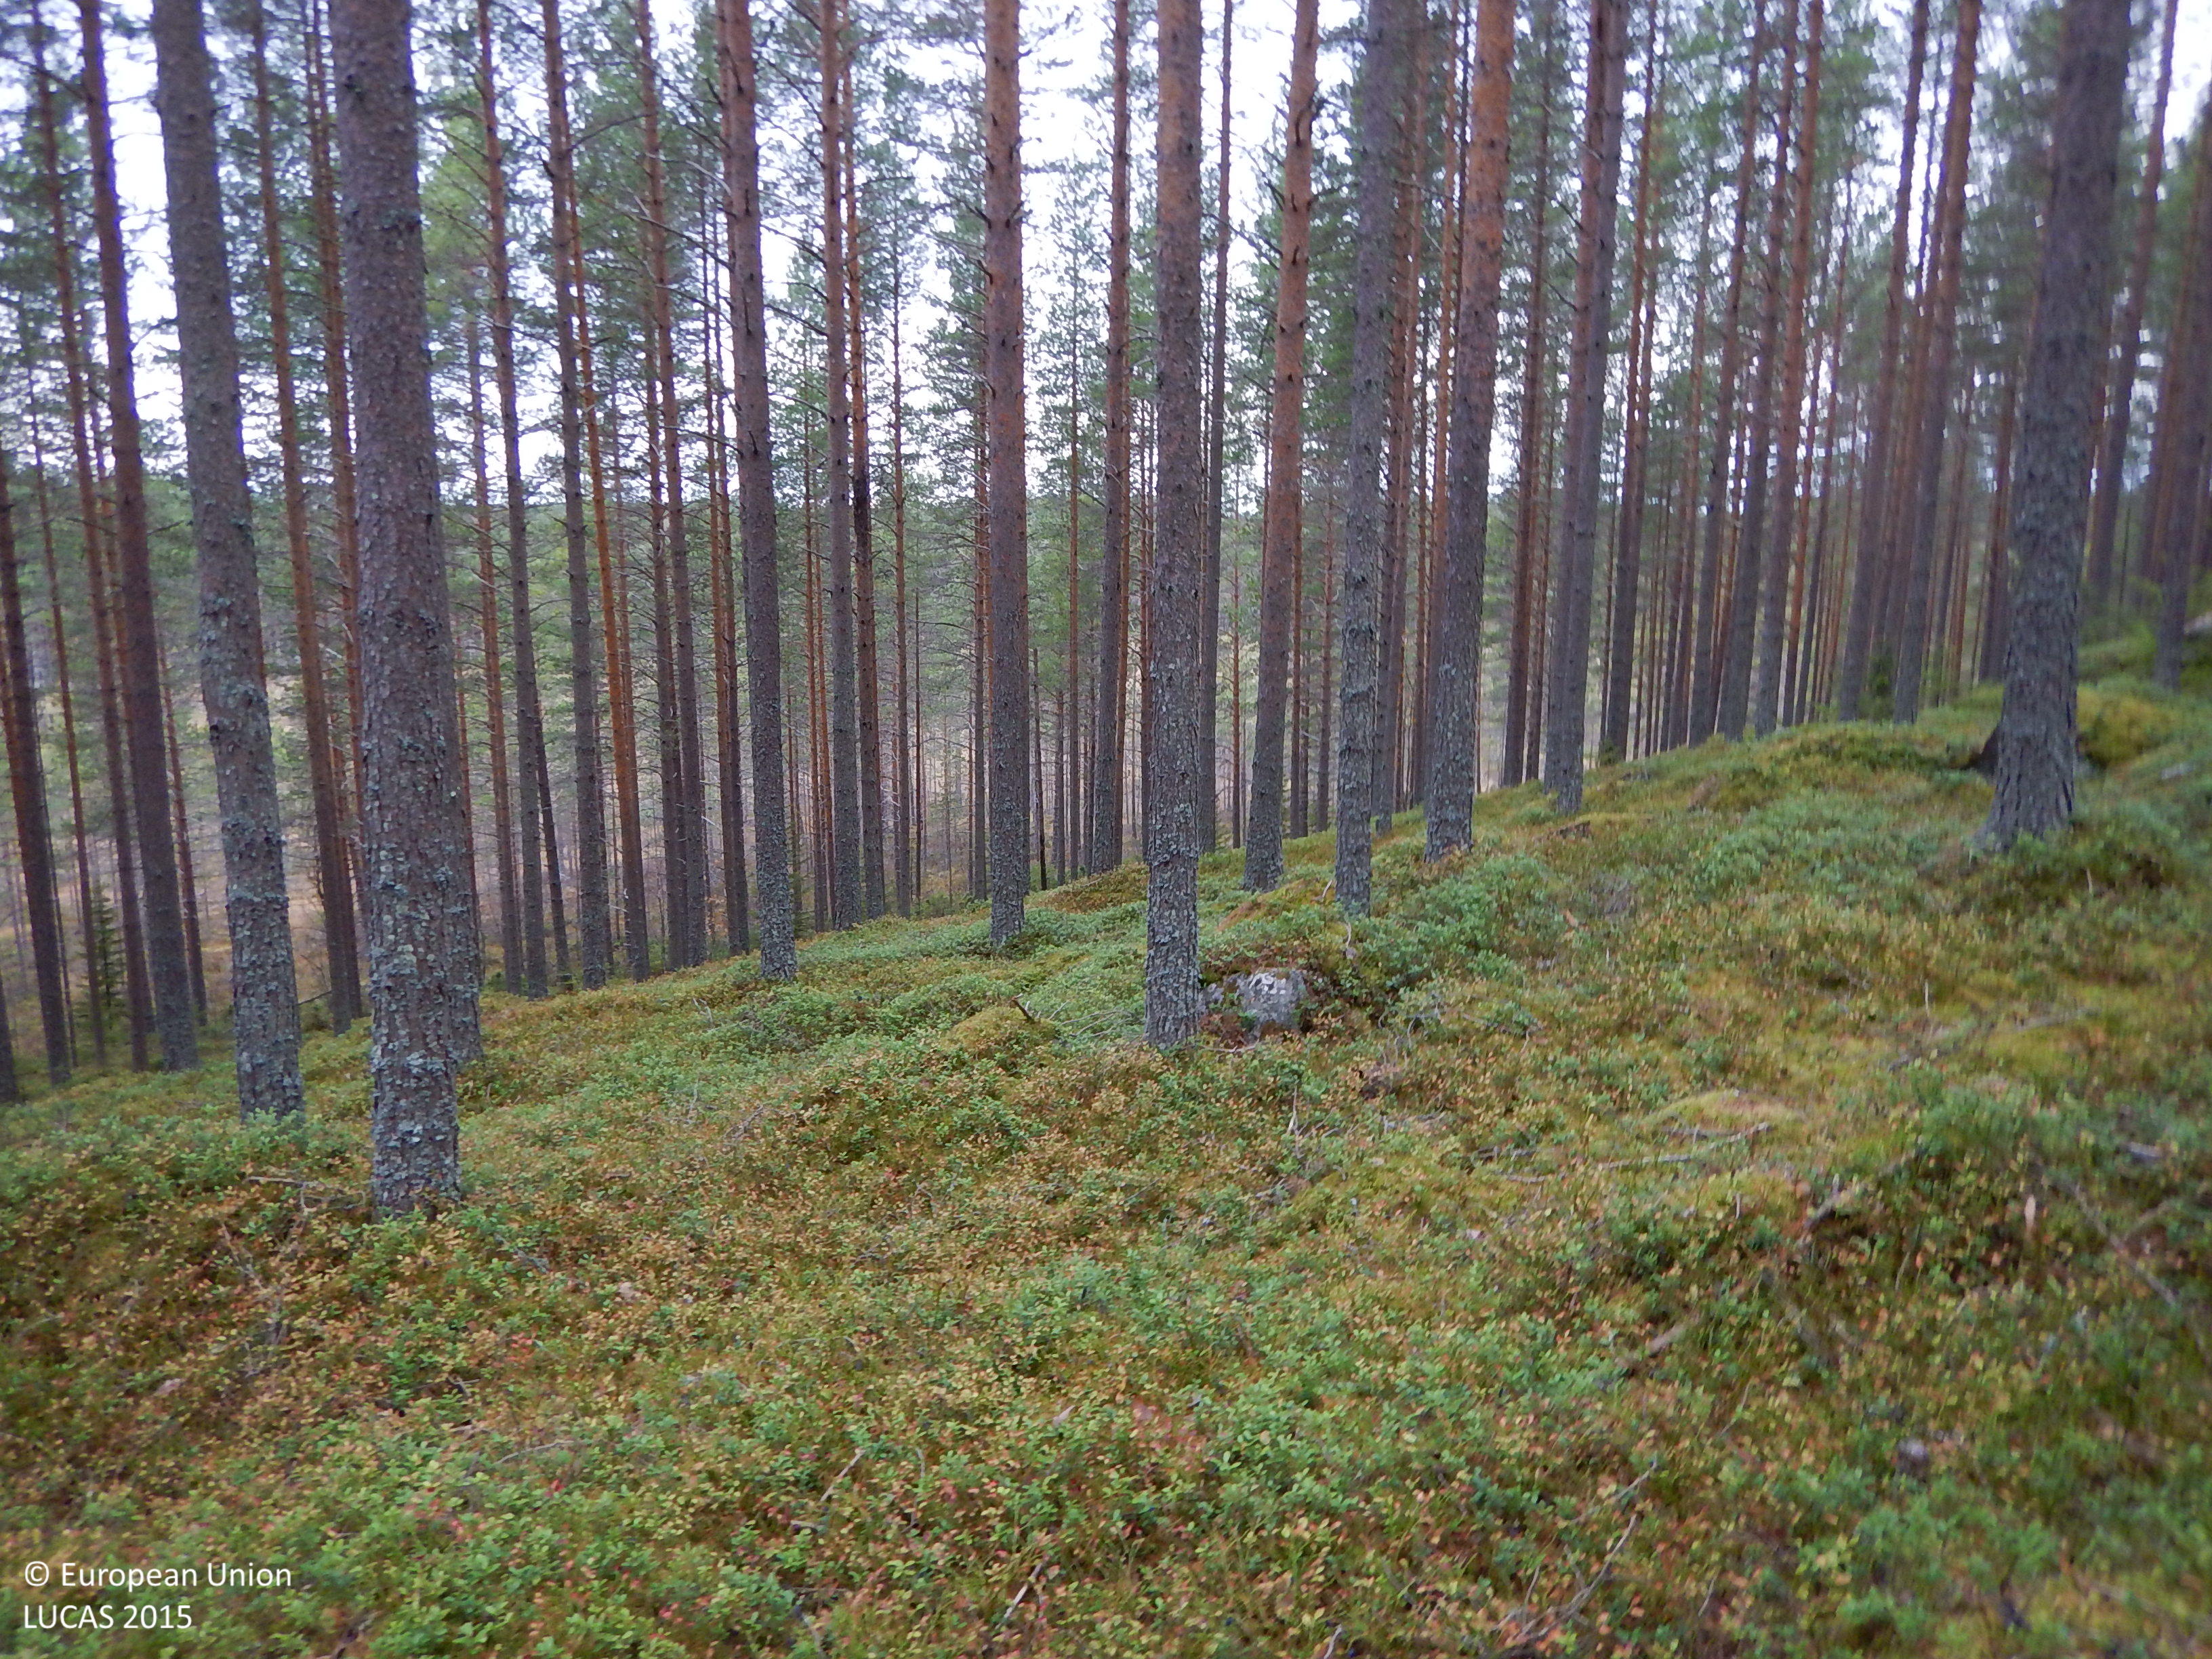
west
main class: Woodland
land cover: Pine dominated coniferous woodland
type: boreal forest
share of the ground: 50 - 75 %
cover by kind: coniferous forest trees 55 %, shrubs 15 %, herbaceous plants 15 %, lichens and mosses 15 %
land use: Forestry
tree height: > 5 m
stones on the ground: < 10 %
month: October
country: SE
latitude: 65.1159
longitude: 21.2006
